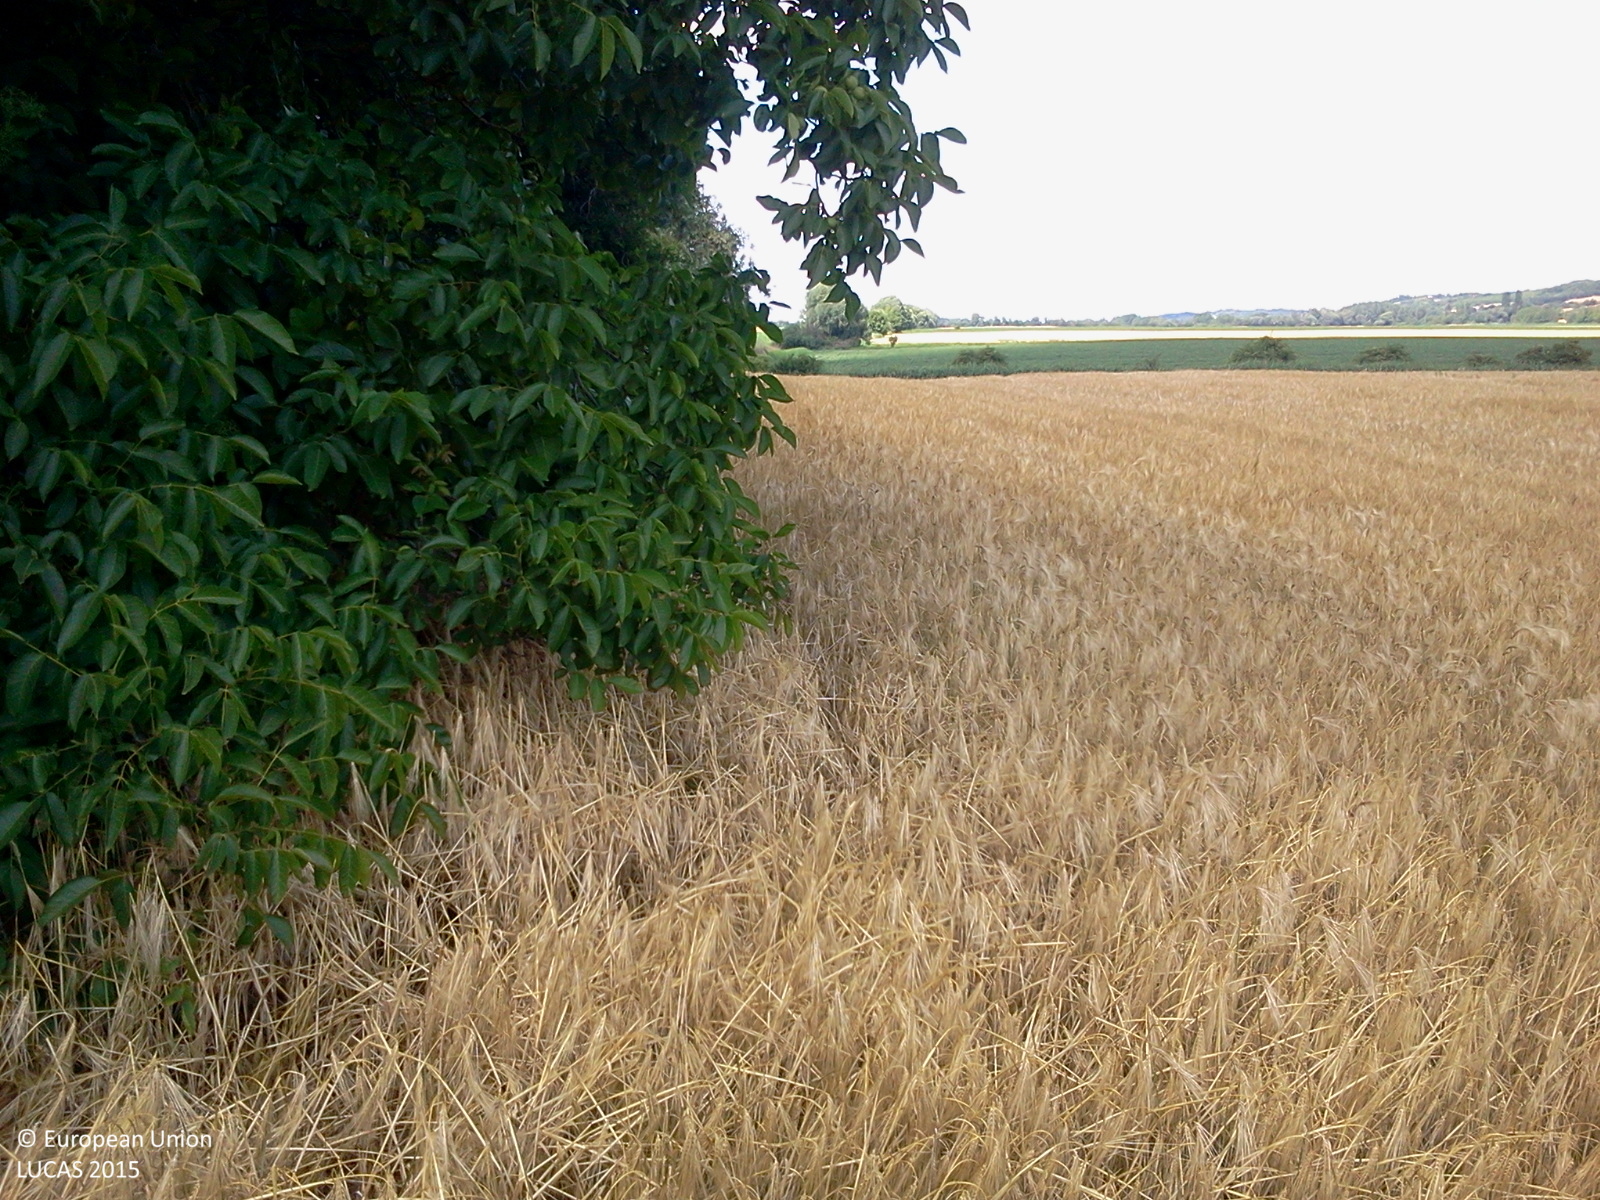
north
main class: Cropland
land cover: Barley
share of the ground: > 75 %
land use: Agriculture (excluding fallow land and kitchen gardens)
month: June
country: HU
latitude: 46.9279
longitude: 17.1098
